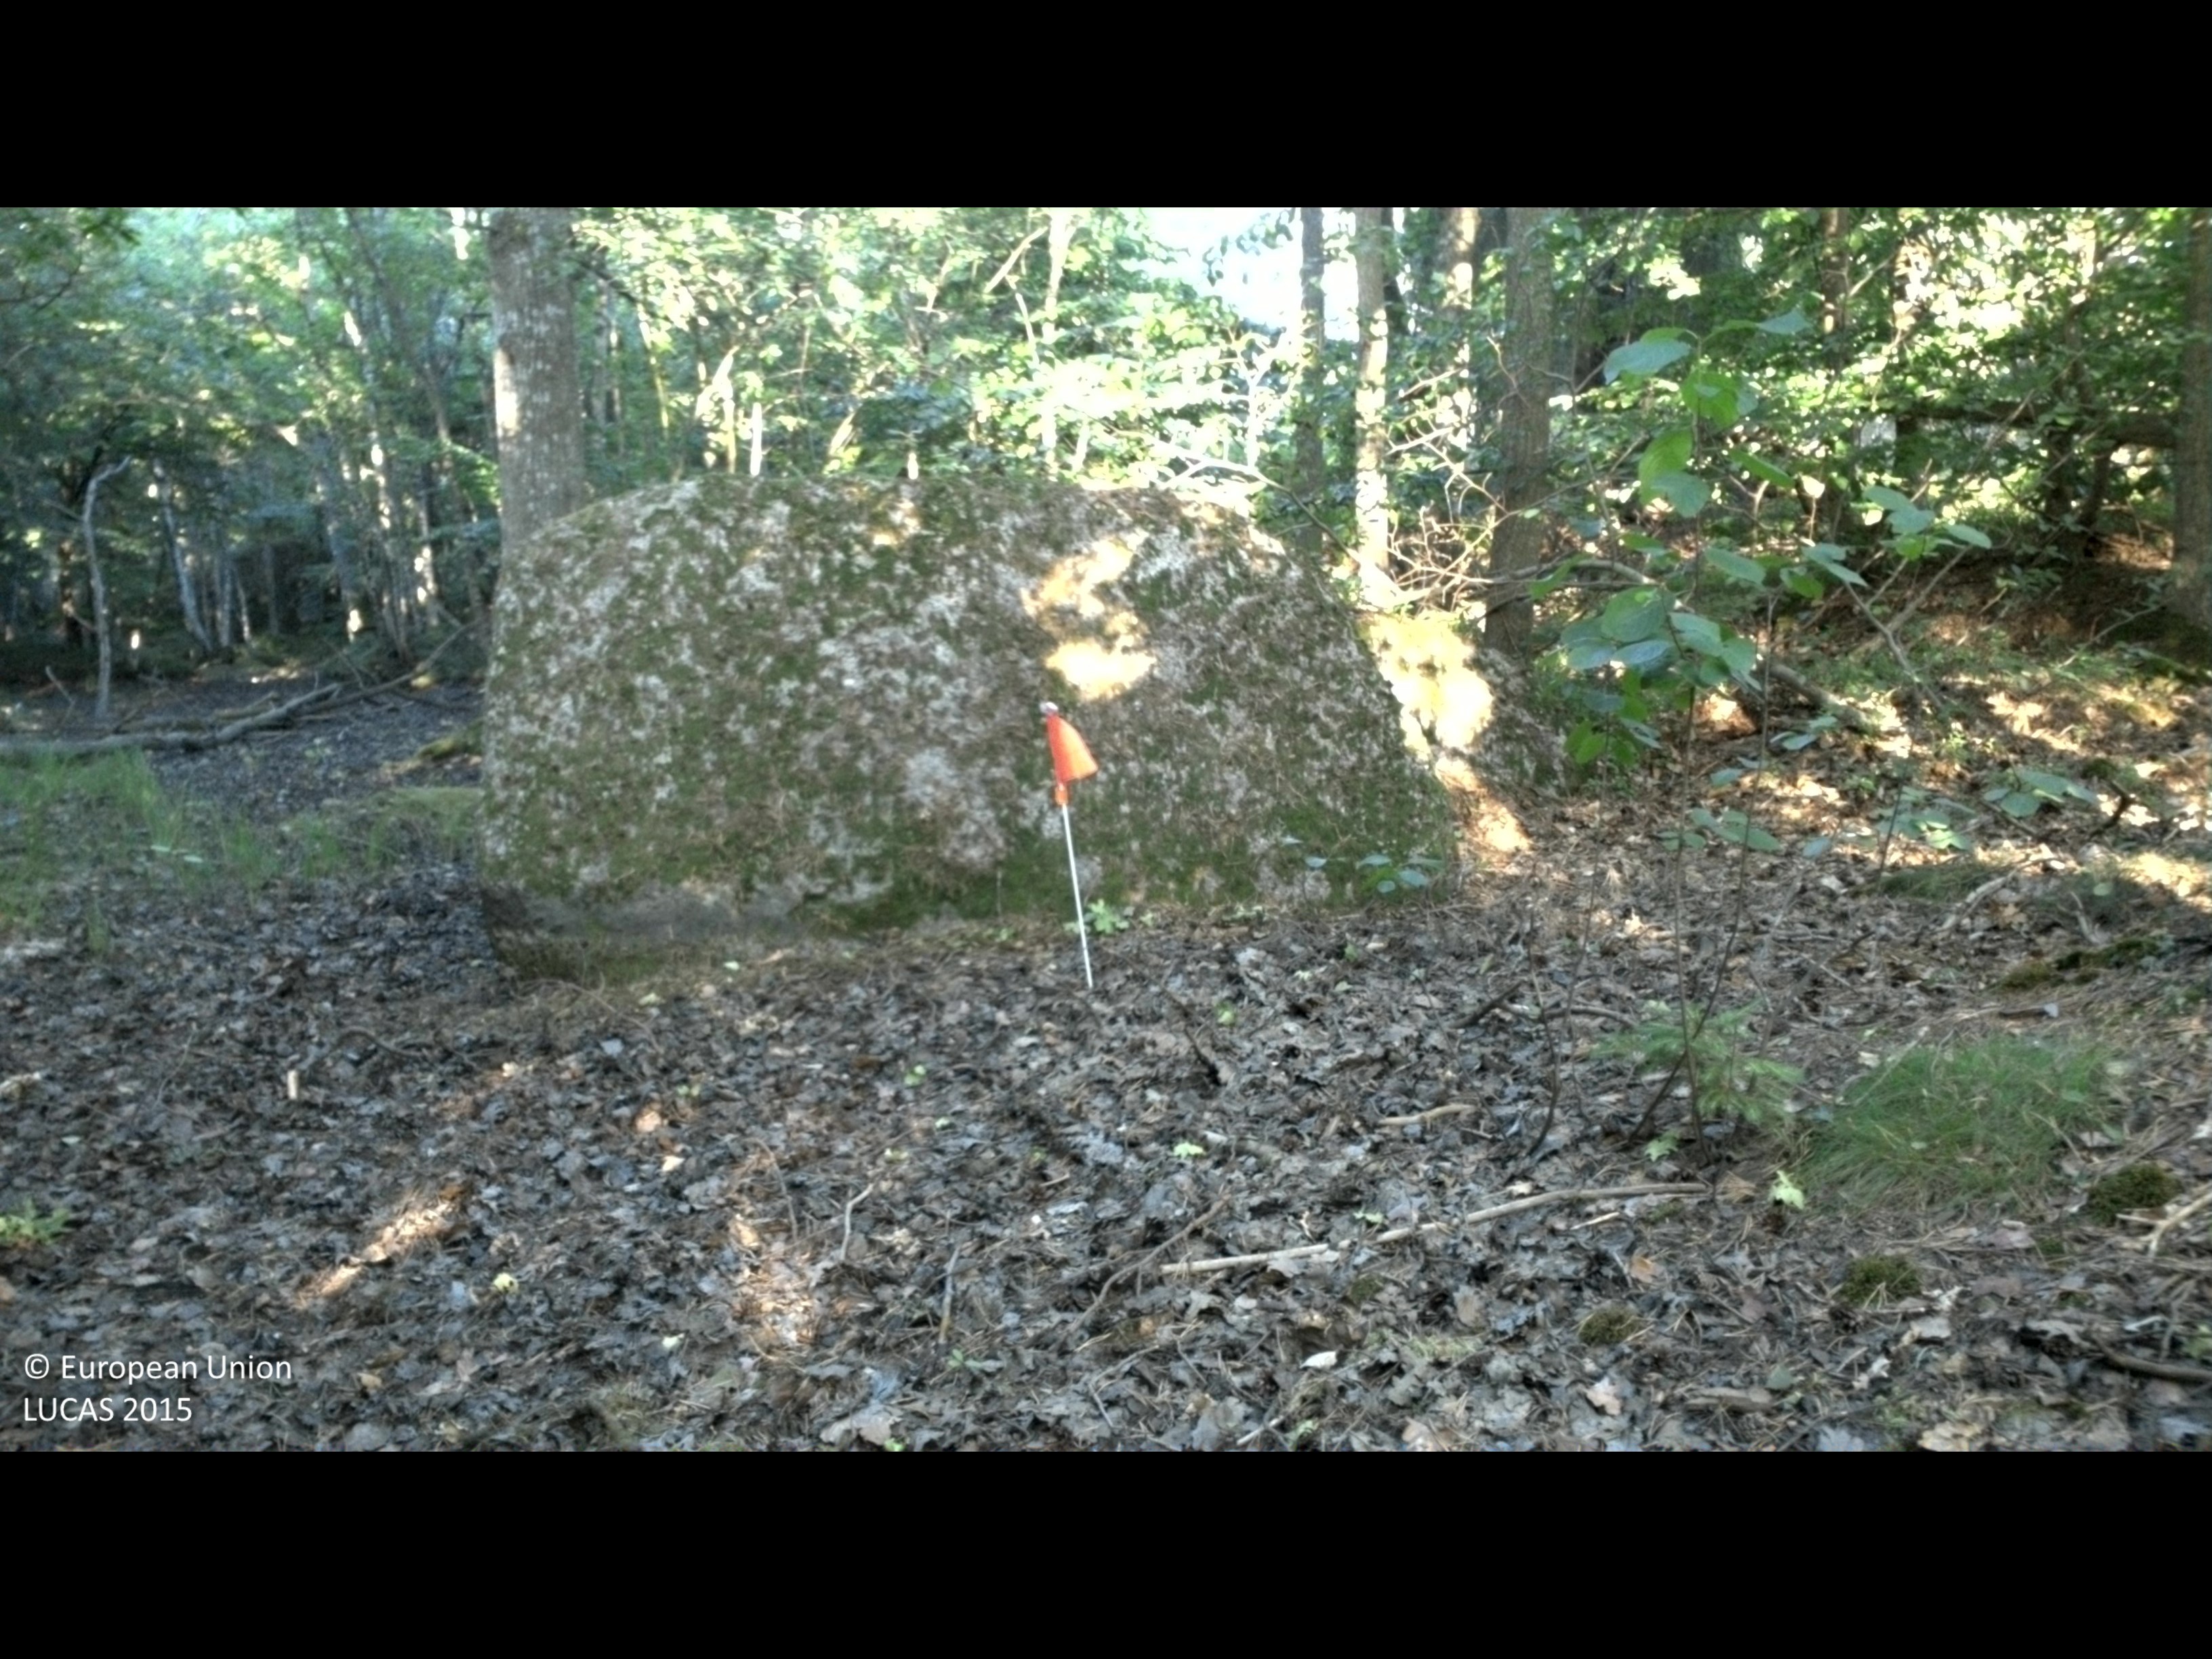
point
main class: Woodland
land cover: Broadleaved woodland
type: mesophytic deciduous forest
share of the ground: 50 - 75 %
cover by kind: broadleaved forest trees 60 %, herbaceous plants 10 %, coniferous forest trees 5 %, lichens and mosses 5 %
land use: Forestry
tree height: > 5 m
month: August
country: SE
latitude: 56.1865
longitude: 15.3002
